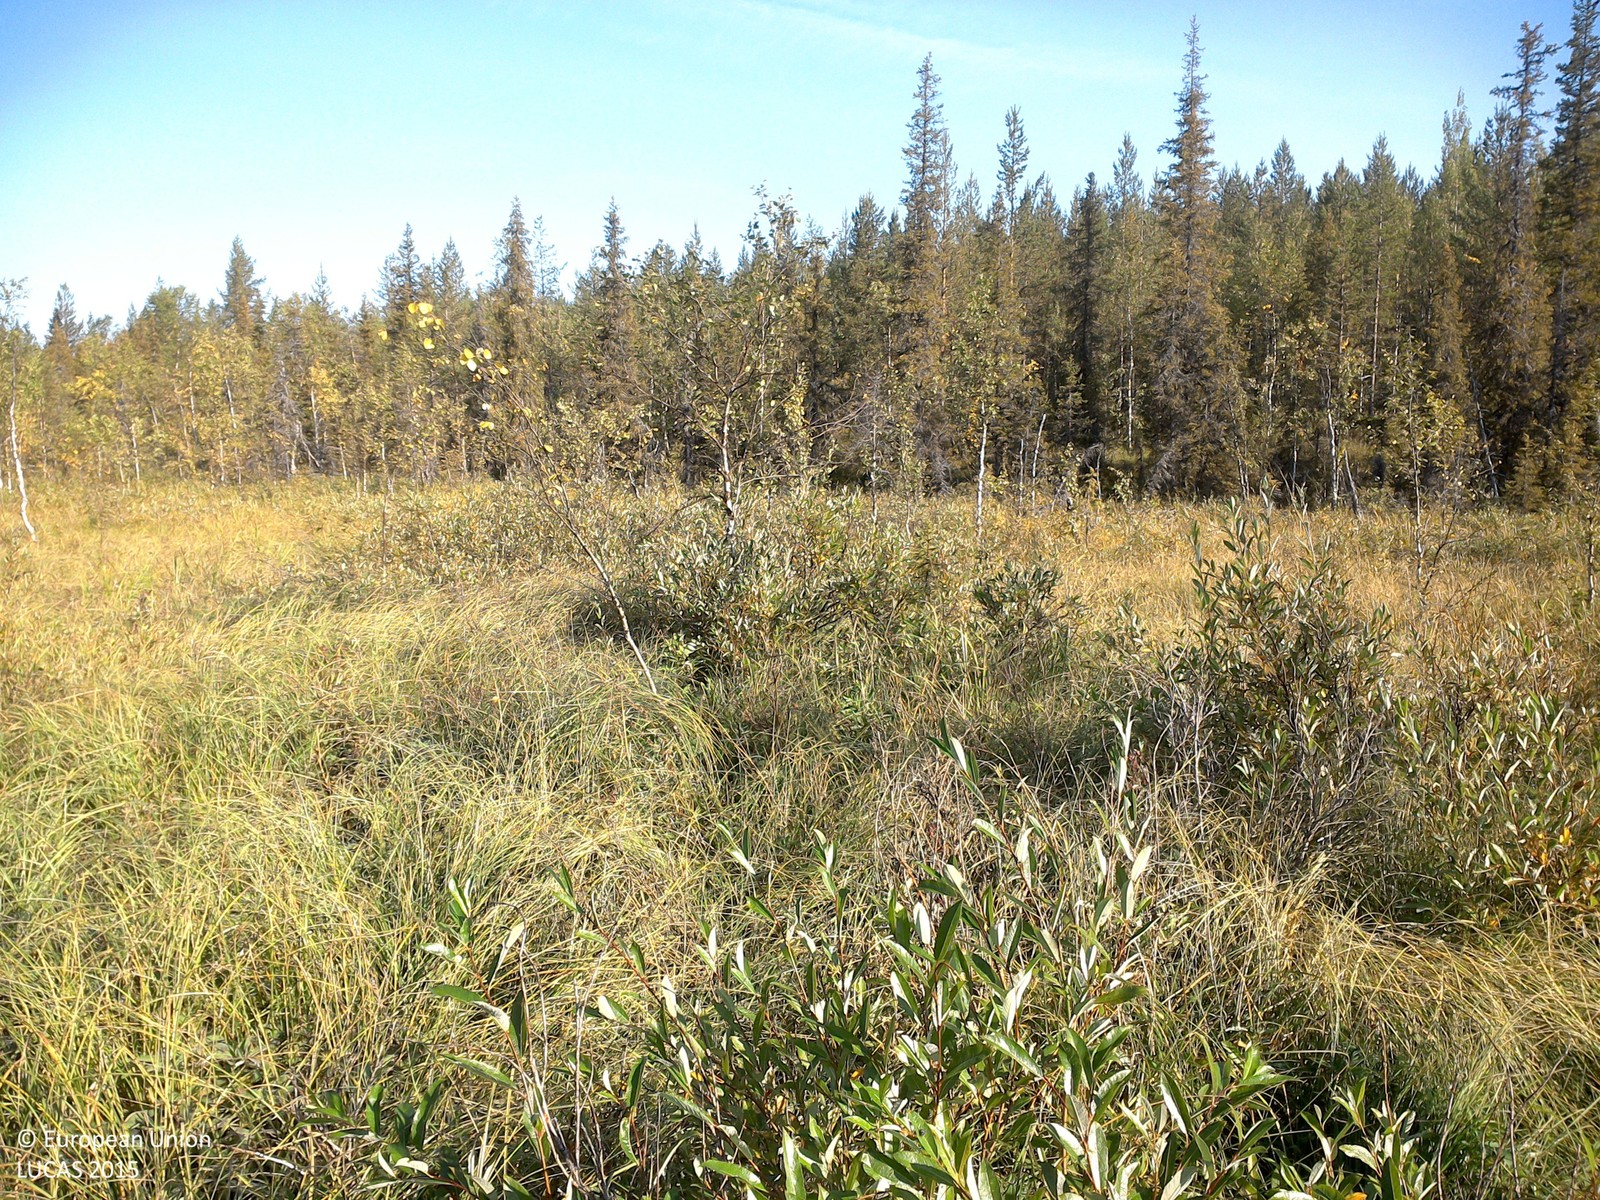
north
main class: Shrubland
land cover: Shrubland with sparse tree cover
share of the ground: 50 - 75 %
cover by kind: shrubs 65 %, herbaceous plants 30 %, broadleaved forest trees 5 %
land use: Semi-natural and natural areas not in use
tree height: < 5 m
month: August
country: SE
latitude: 67.1016
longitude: 21.9110
